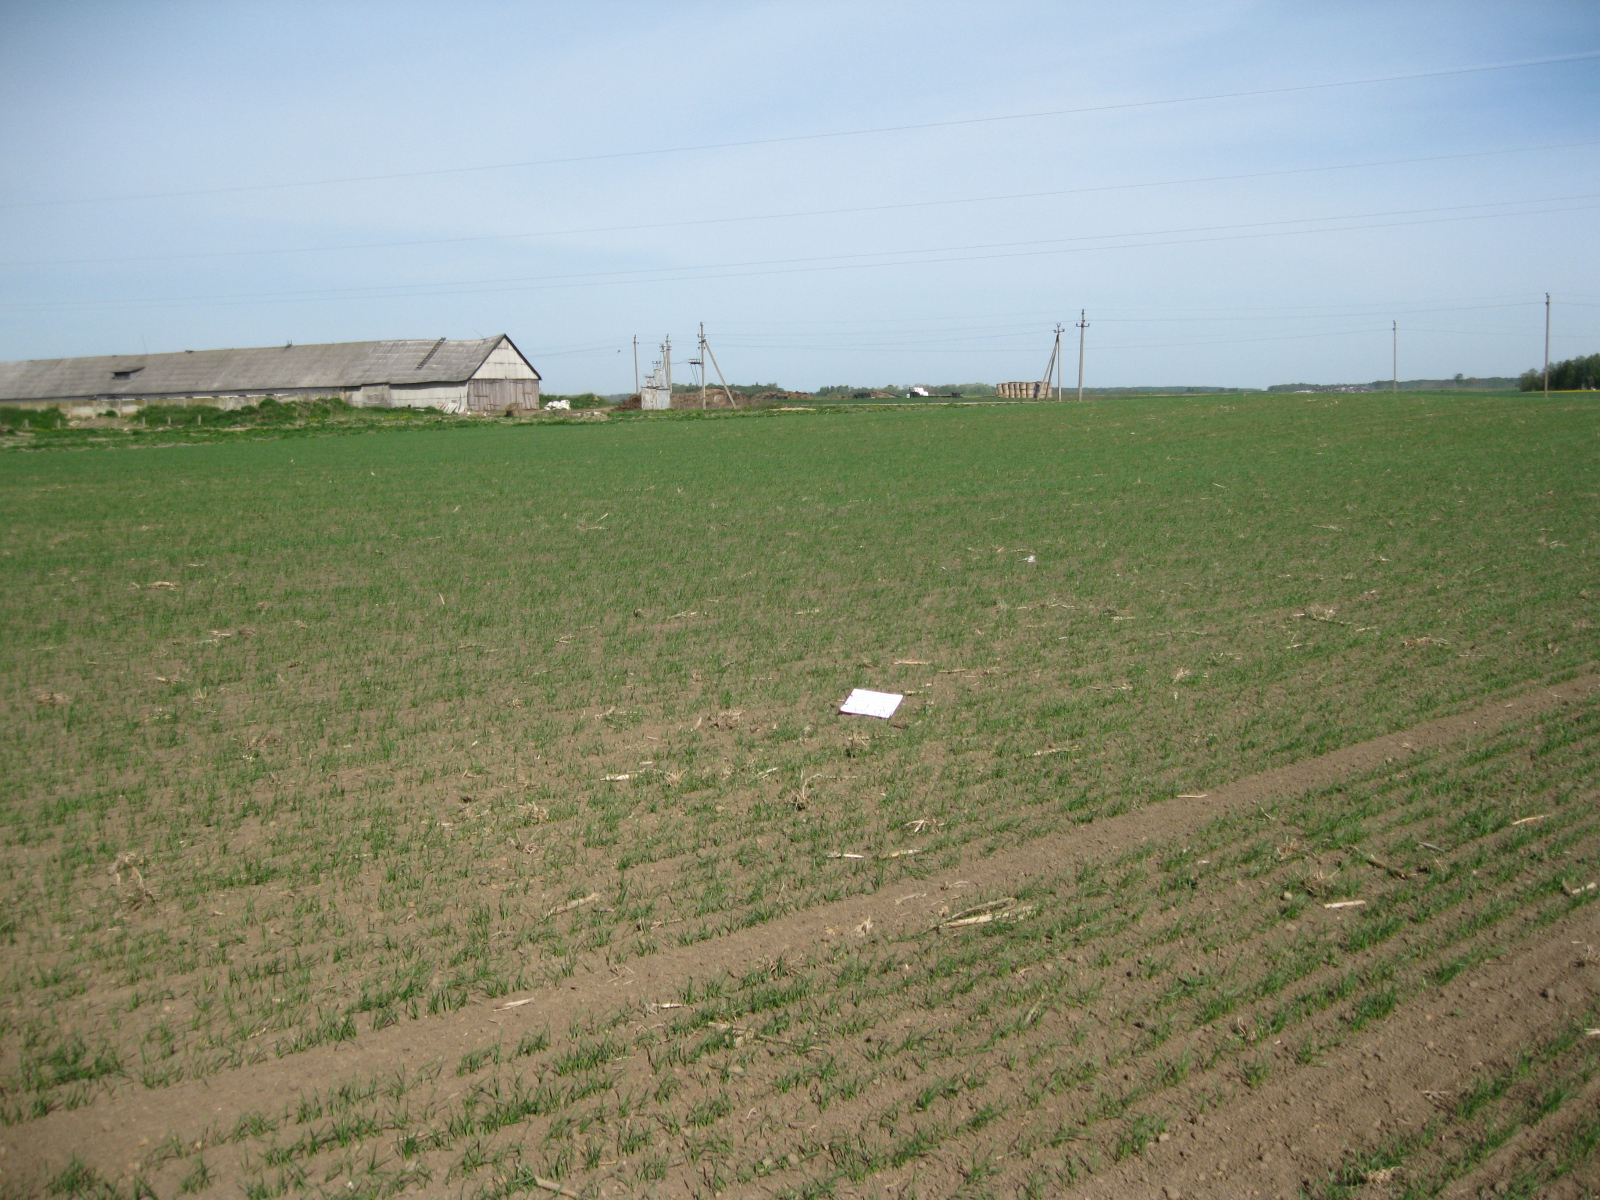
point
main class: Cropland
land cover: Common wheat
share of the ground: < 10 %
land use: Agriculture (excluding fallow land and kitchen gardens)
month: May
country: LT
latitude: 56.1769
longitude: 24.2183
